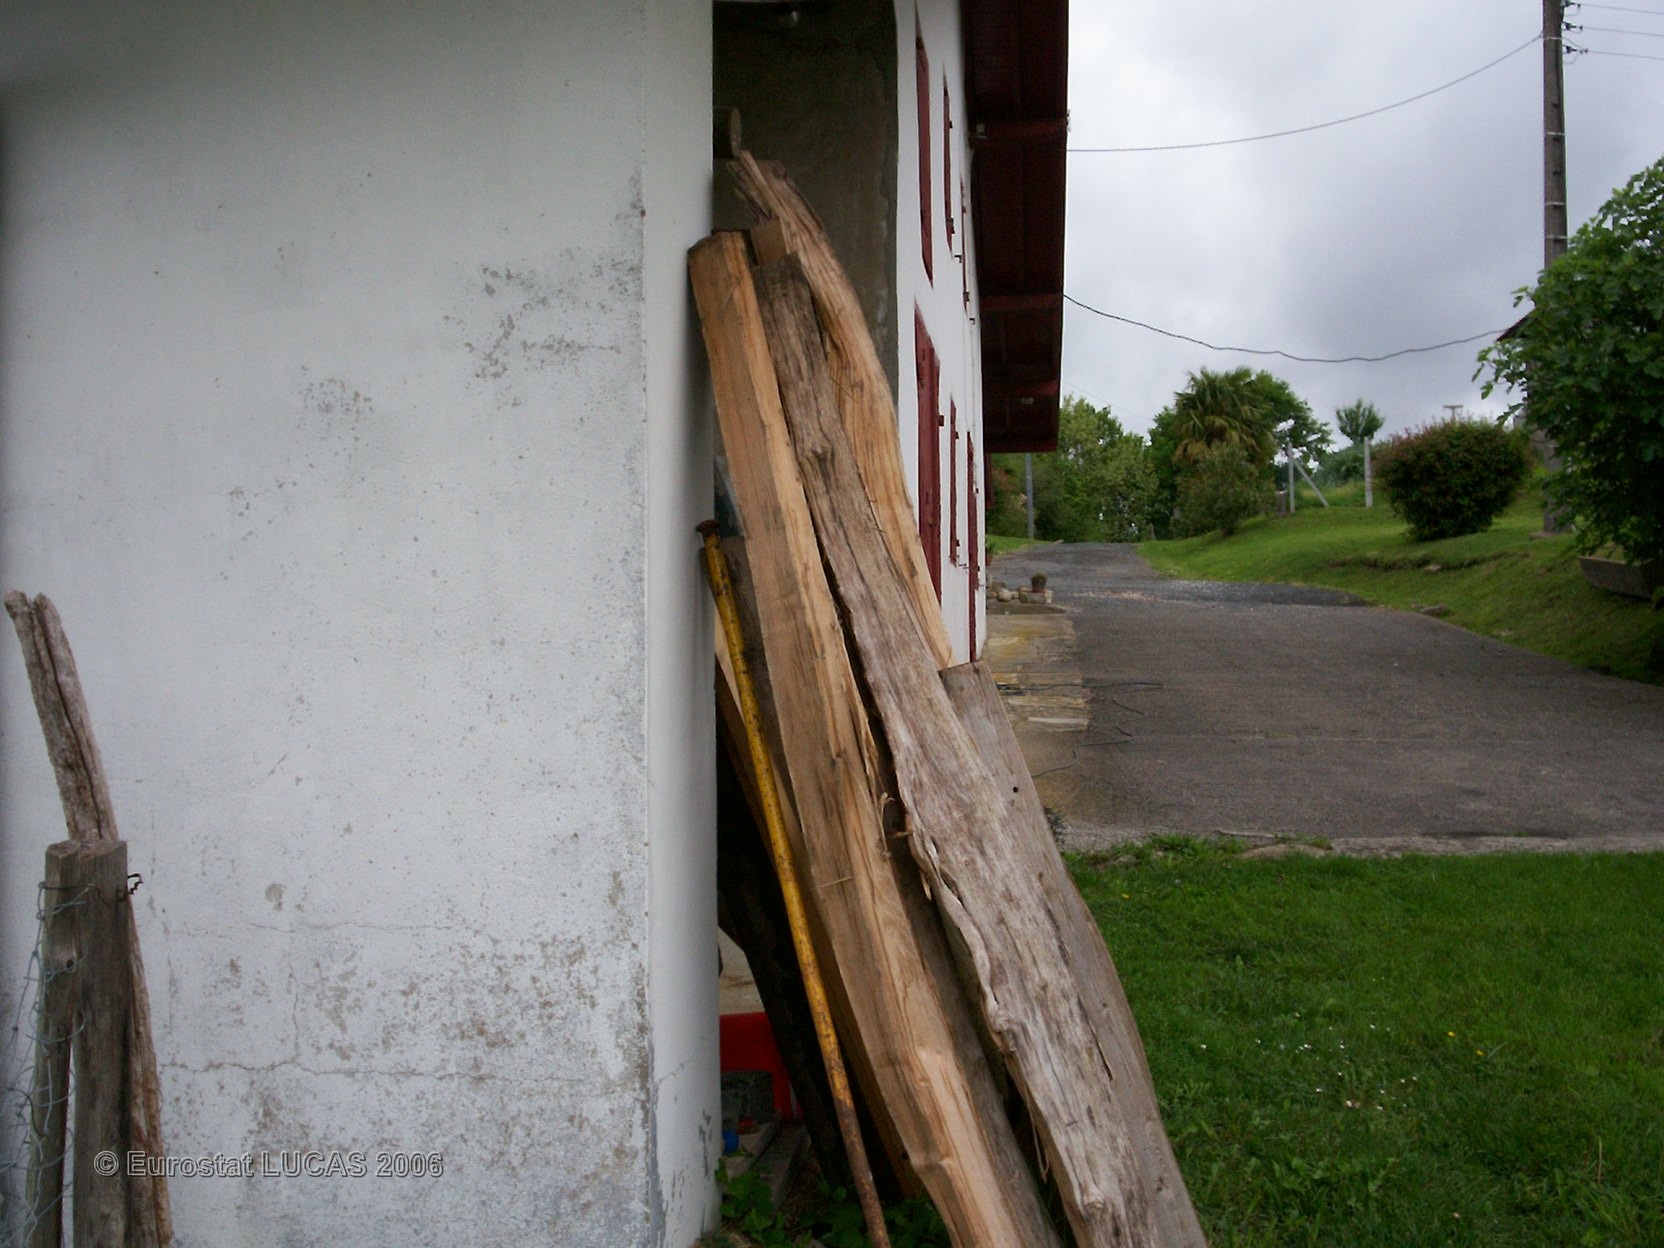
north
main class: Grassland
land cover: Grassland without tree/shrub cover
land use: Agriculture (excluding fallow land and kitchen gardens)
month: April
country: FR
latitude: 43.4830
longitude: -1.4048
